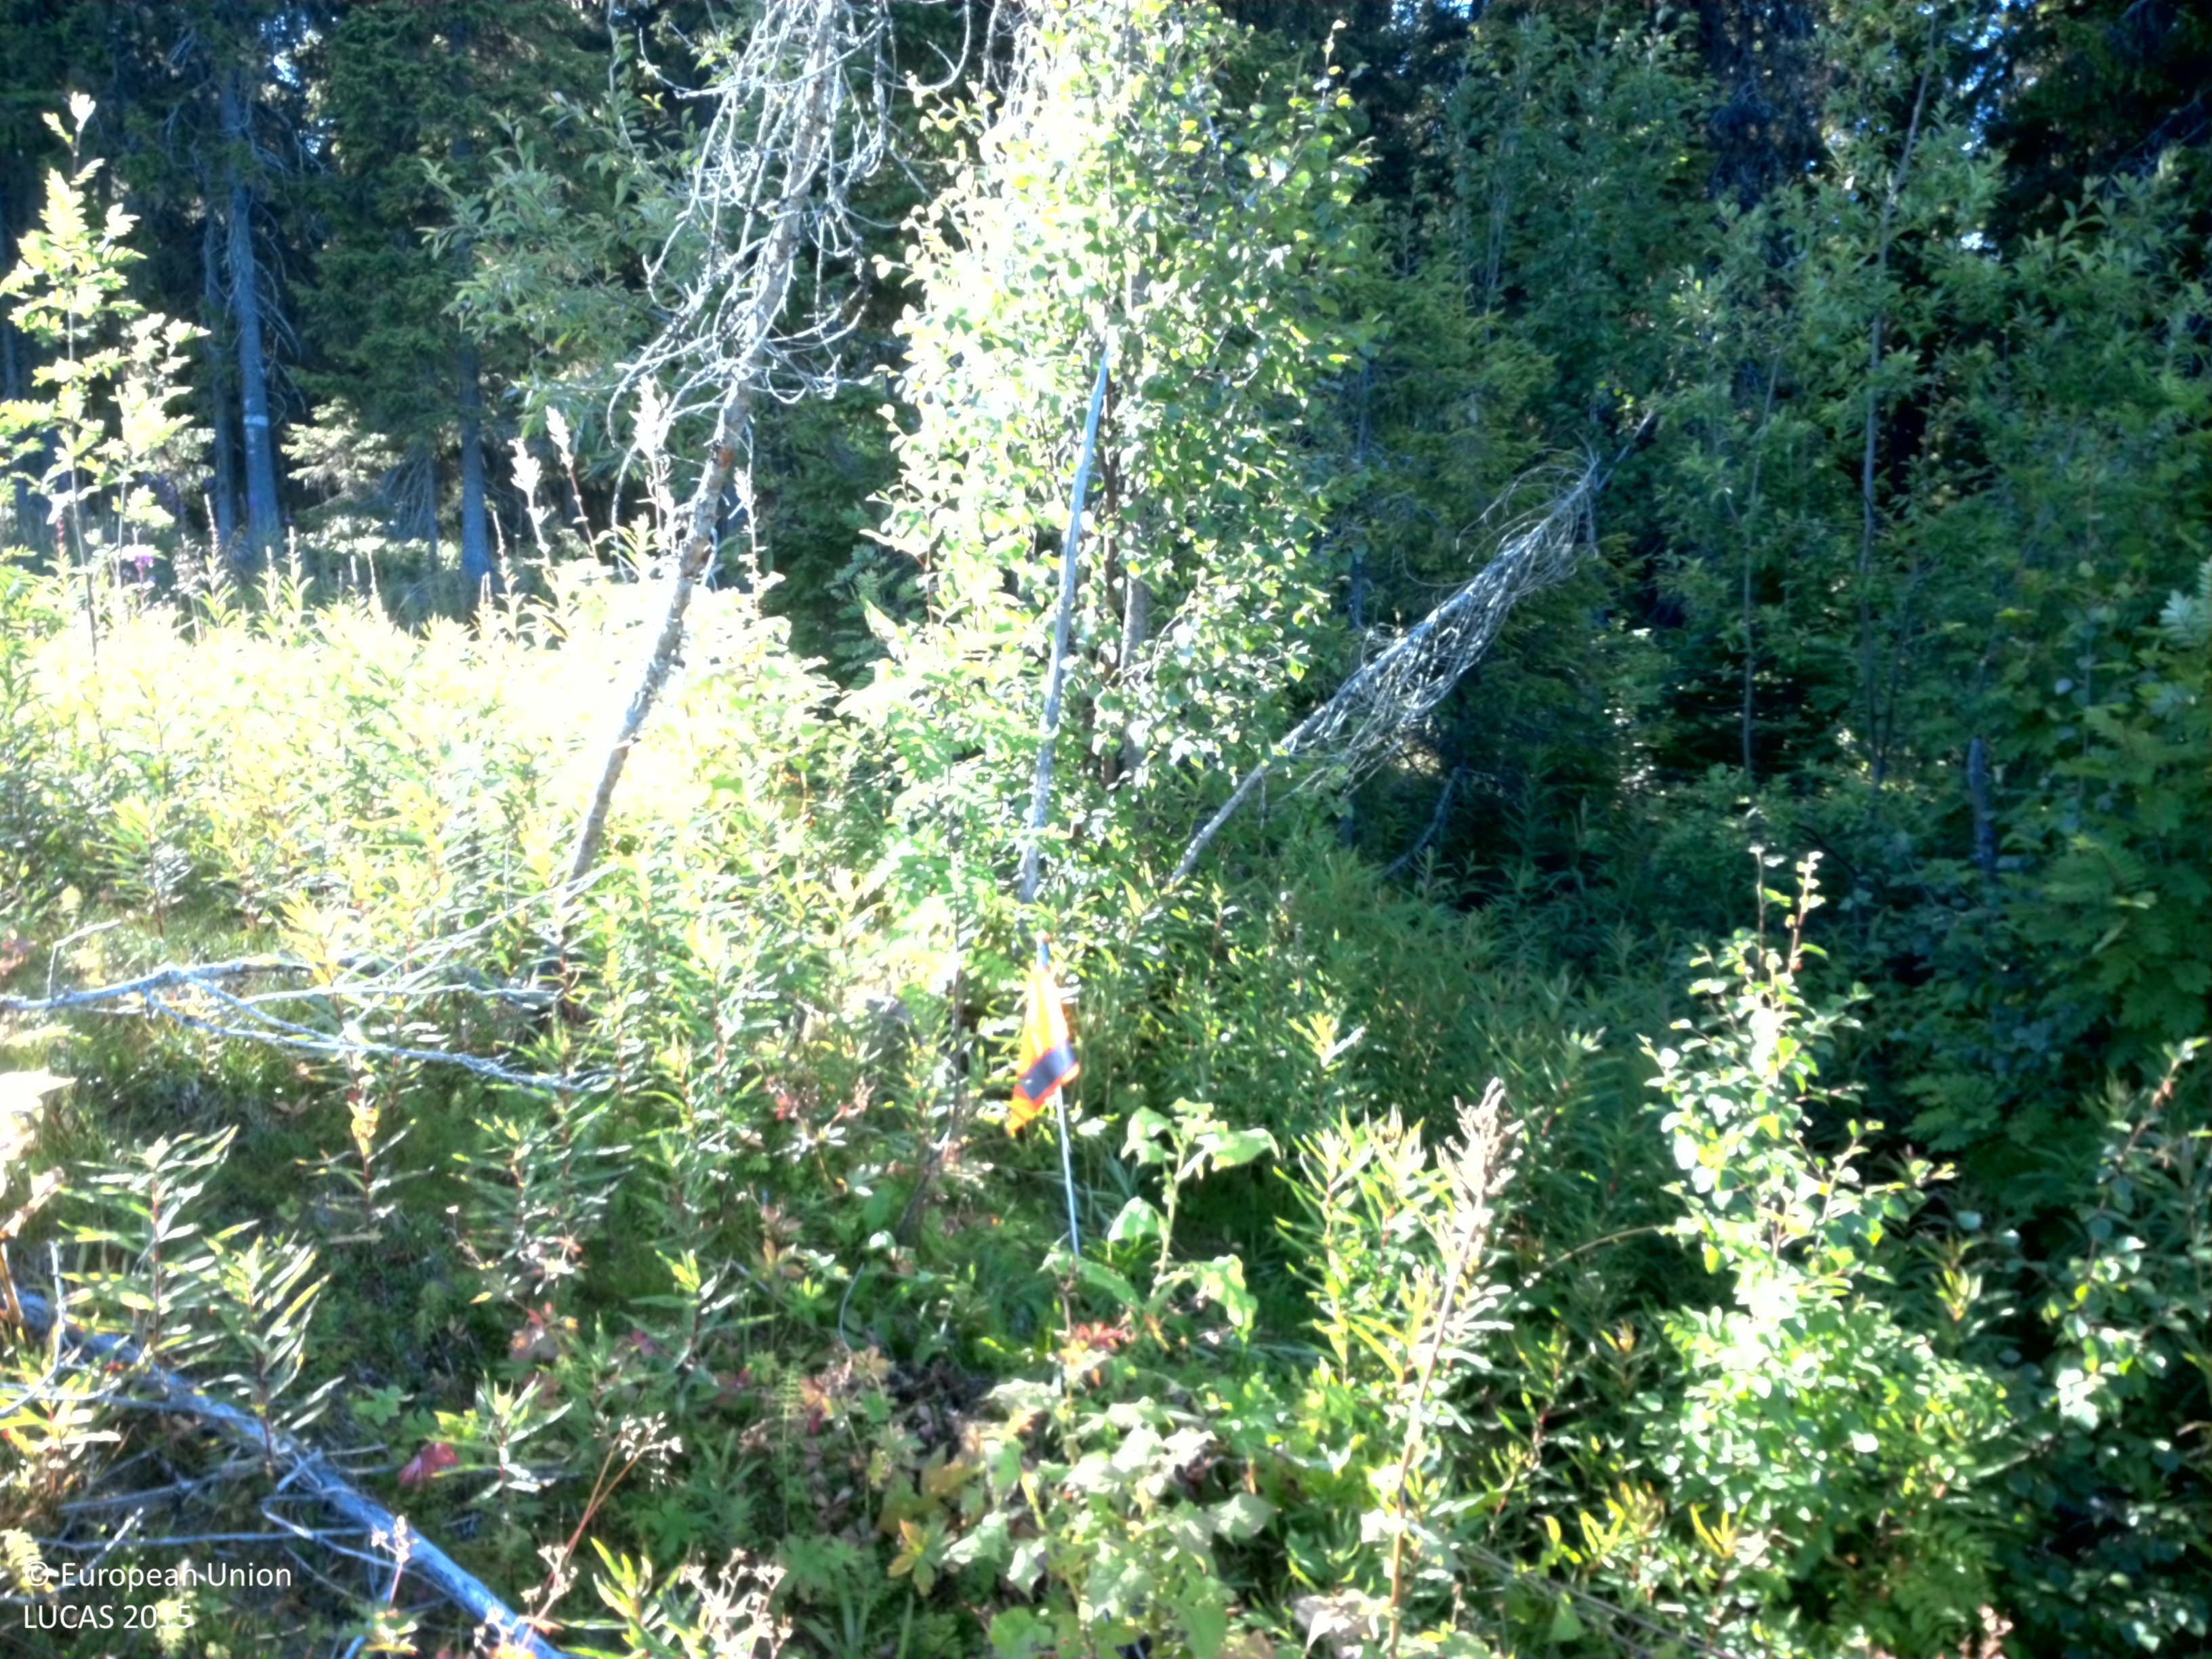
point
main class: Woodland
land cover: Spruce dominated mixed woodland
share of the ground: 10 - 25 %
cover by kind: herbaceous plants 75 %, broadleaved forest trees 10 %, shrubs 10 %, coniferous forest trees 5 %
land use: Forestry
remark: Clear cut
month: August
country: SE
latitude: 64.6972
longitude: 16.1115
